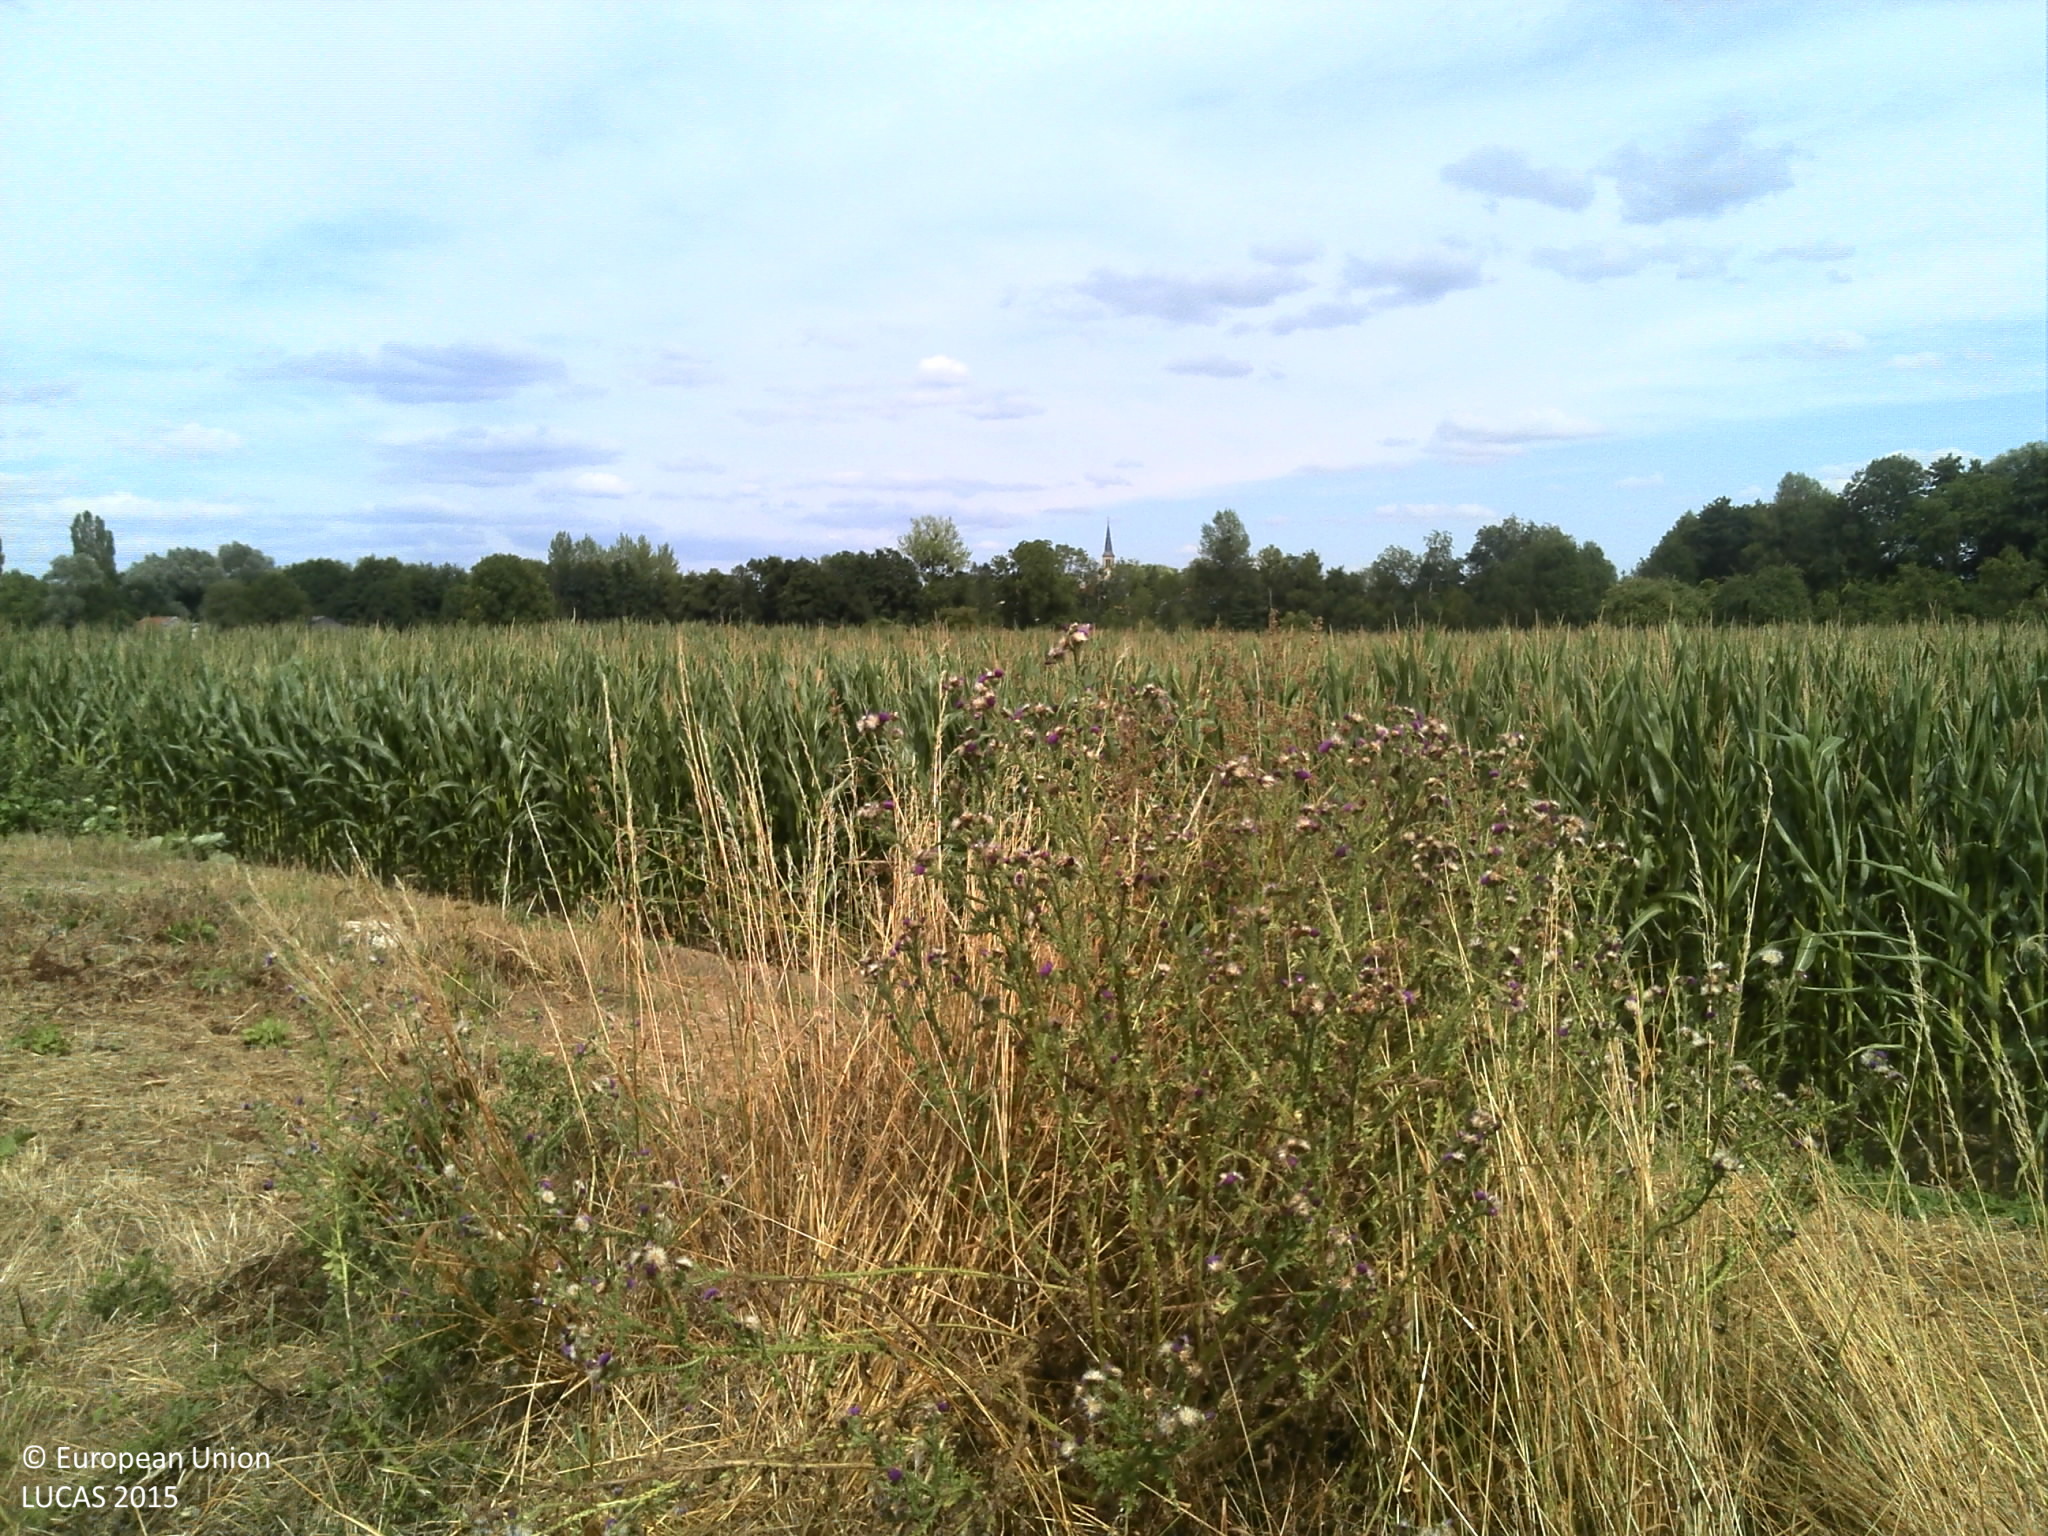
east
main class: Grassland
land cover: Grassland without tree/shrub cover
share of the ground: > 75 %
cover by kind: herbaceous plants 100 %
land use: Agriculture (excluding fallow land and kitchen gardens)
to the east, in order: Grassland without tree/shrub cover; Maize; Grass margins; Ditches and canals; Paved roads, cycling and walking lanes; Grass margins; Ditches and canals; Barley
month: July
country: FR
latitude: 49.4975
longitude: 4.5979
